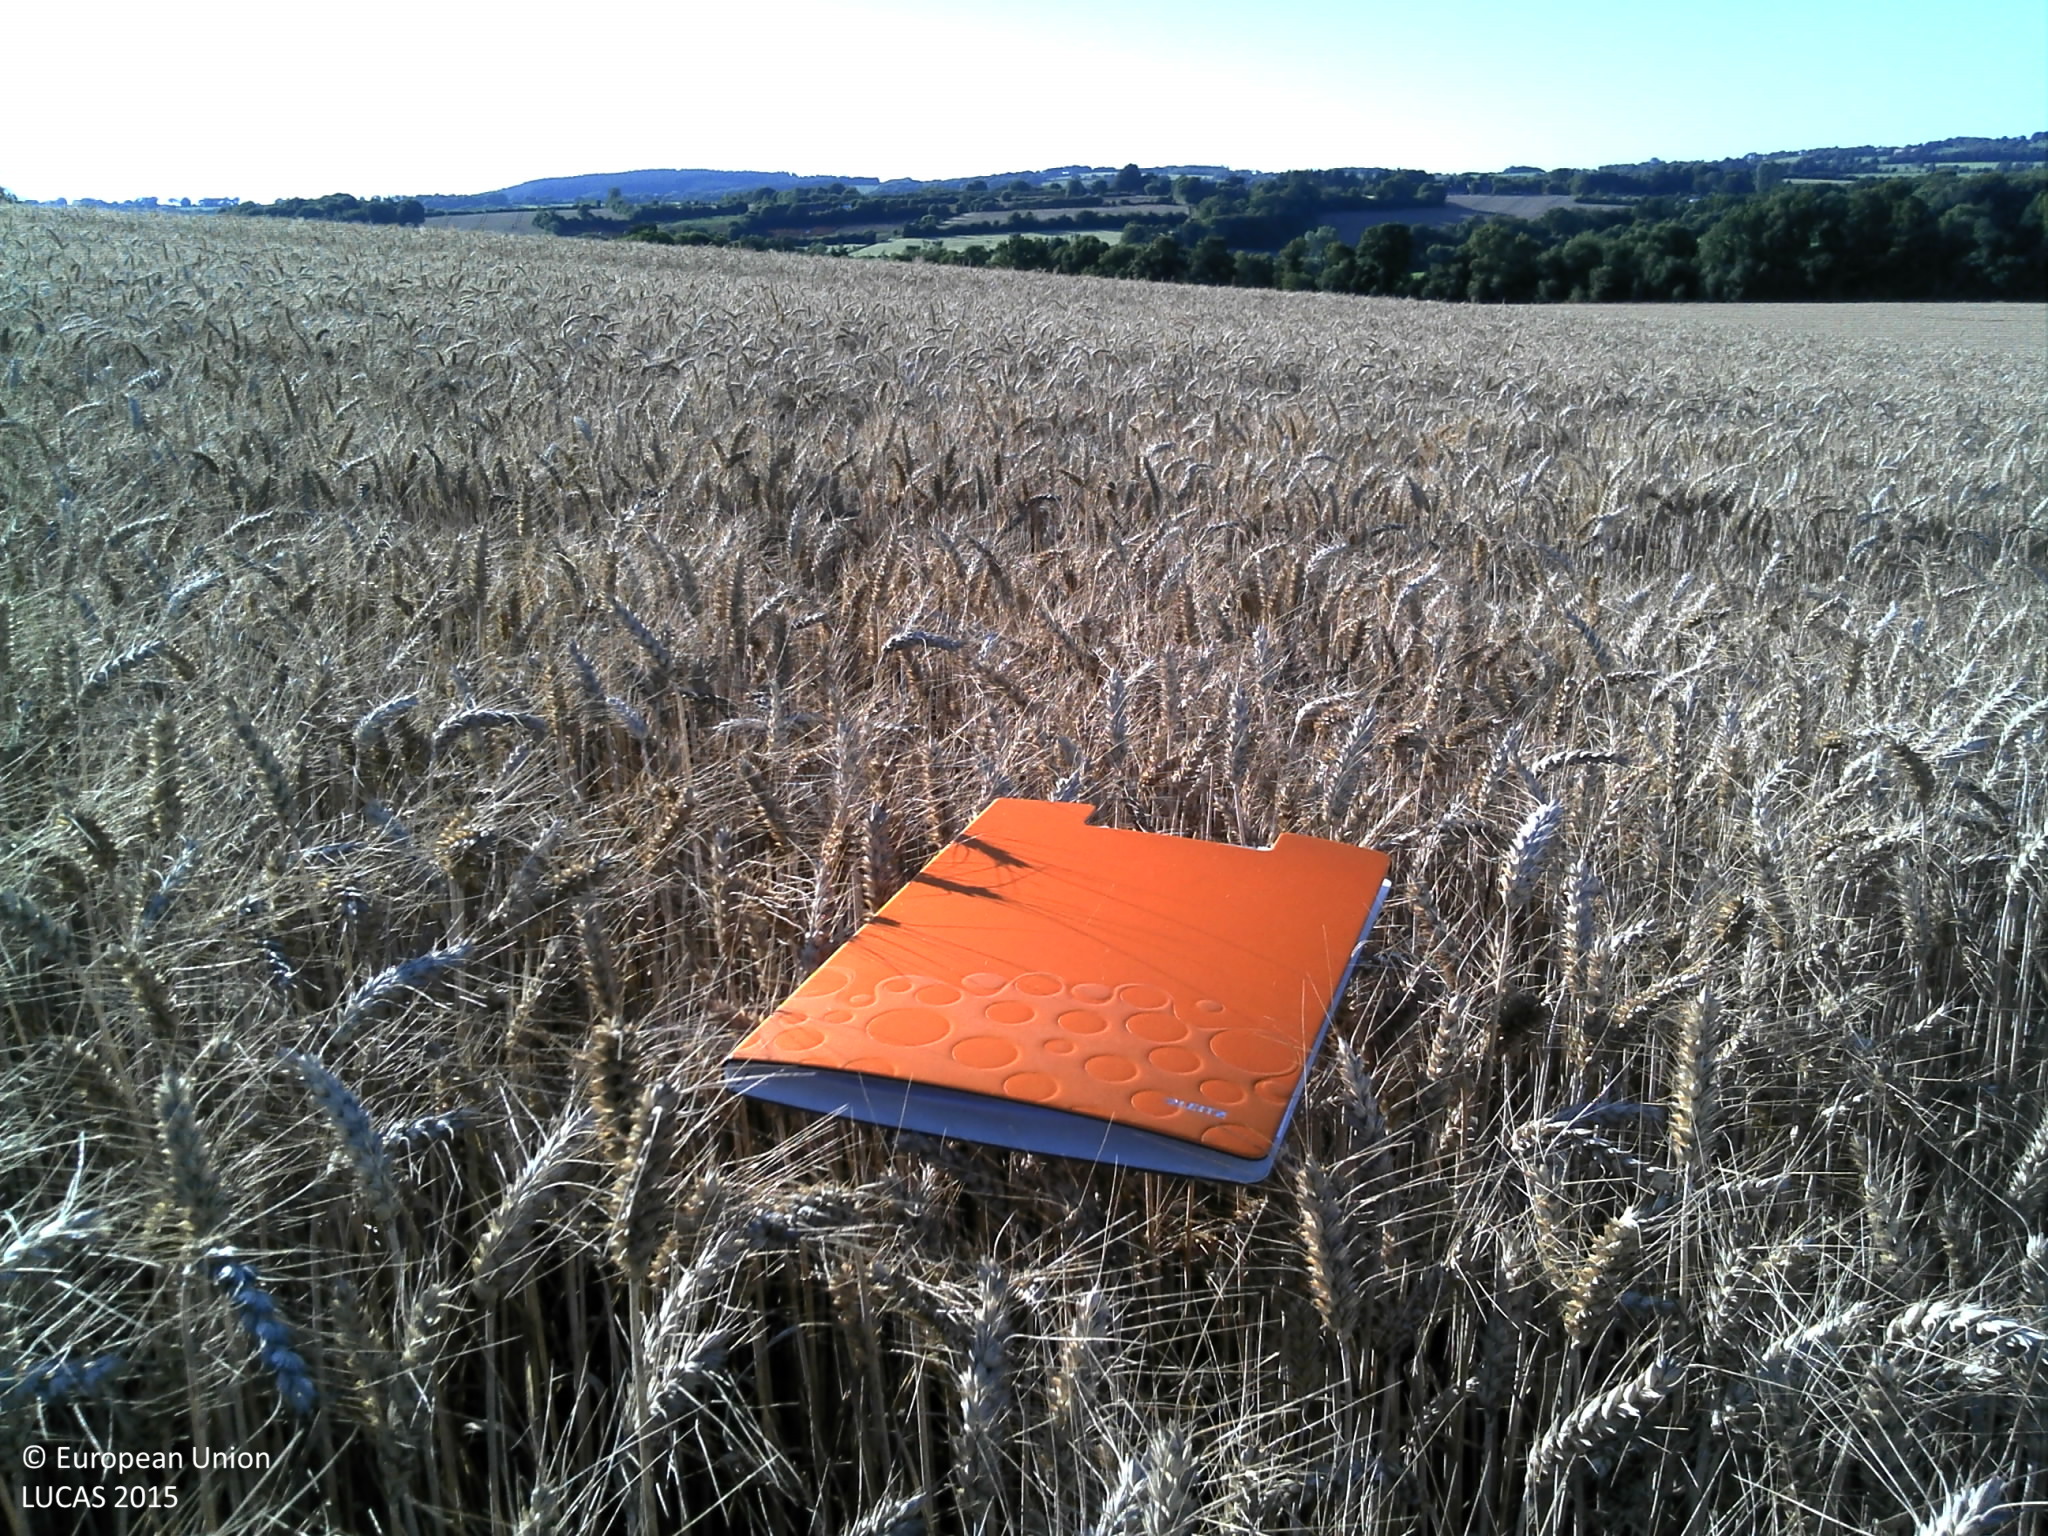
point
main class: Cropland
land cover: Common wheat
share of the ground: > 75 %
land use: Agriculture (excluding fallow land and kitchen gardens)
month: July
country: FR
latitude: 48.4581
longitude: -3.6998
